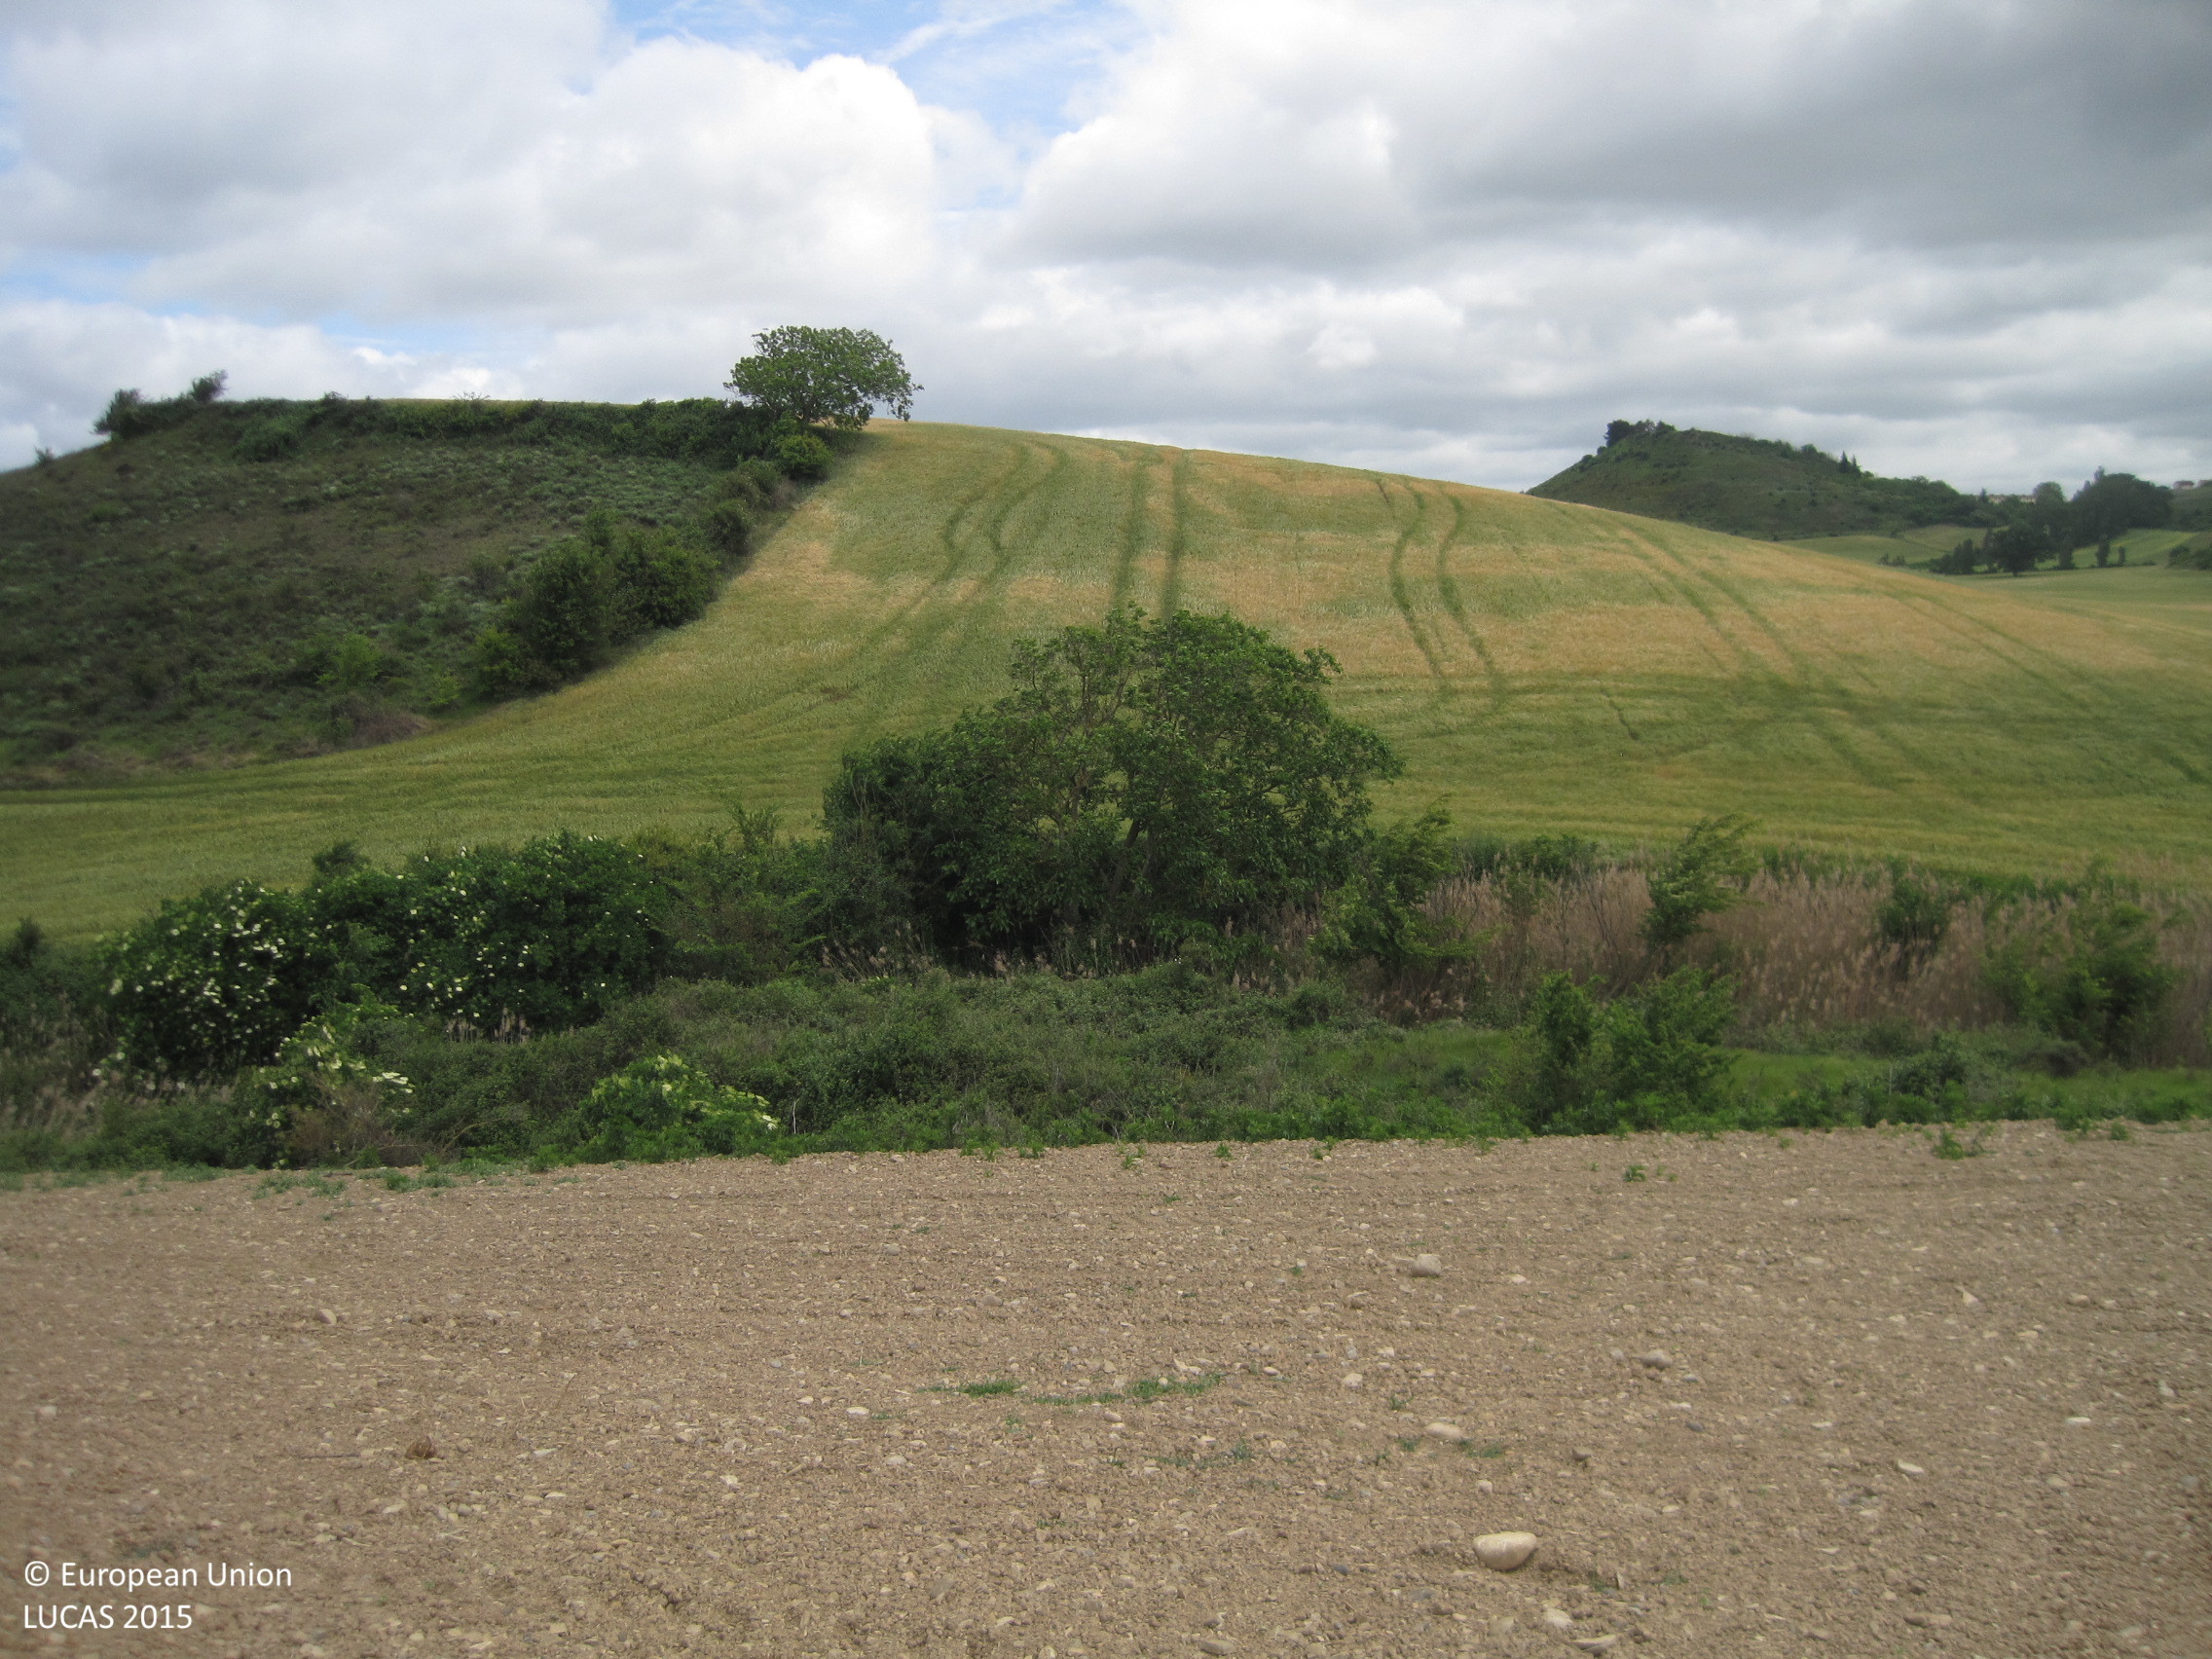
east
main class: Cropland
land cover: Sunflower
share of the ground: < 10 %
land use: Agriculture (excluding fallow land and kitchen gardens)
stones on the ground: < 10 %
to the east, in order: Sunflower; Shrubland without tree cover; Ditches and canals; Shrubland without tree cover; Barley
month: May
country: ES
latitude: 42.7685
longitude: -1.7598
